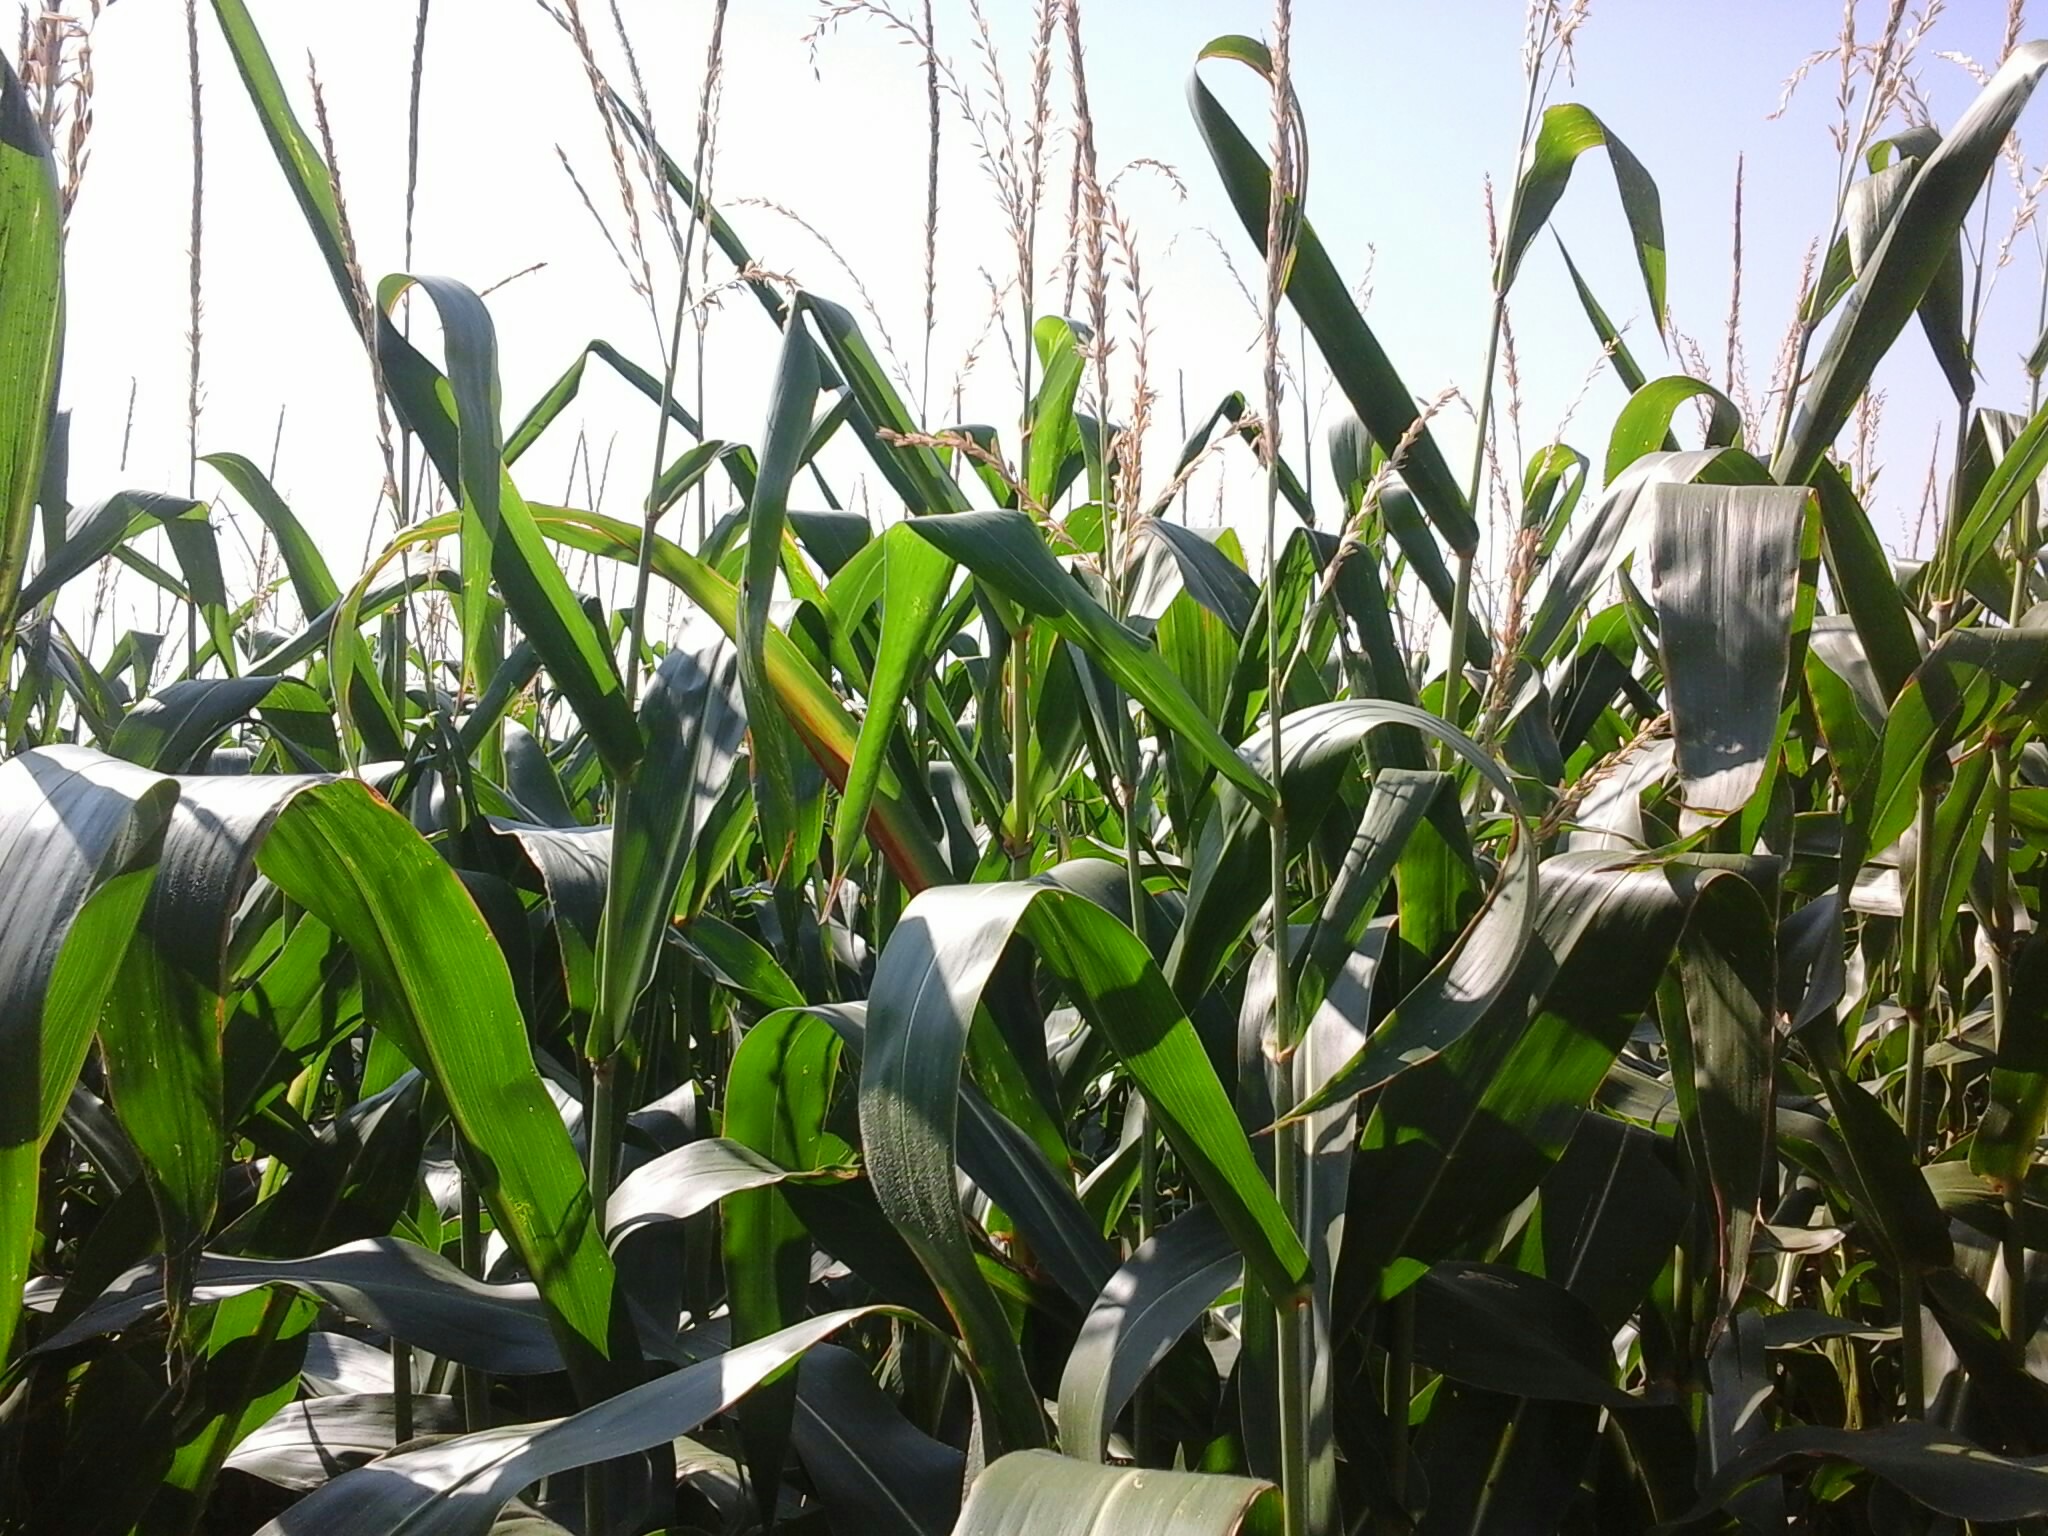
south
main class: Cropland
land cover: Maize
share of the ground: > 75 %
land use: Agriculture (excluding fallow land and kitchen gardens)
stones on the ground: < 10 %
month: August
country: HU
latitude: 47.1320
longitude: 18.3038
